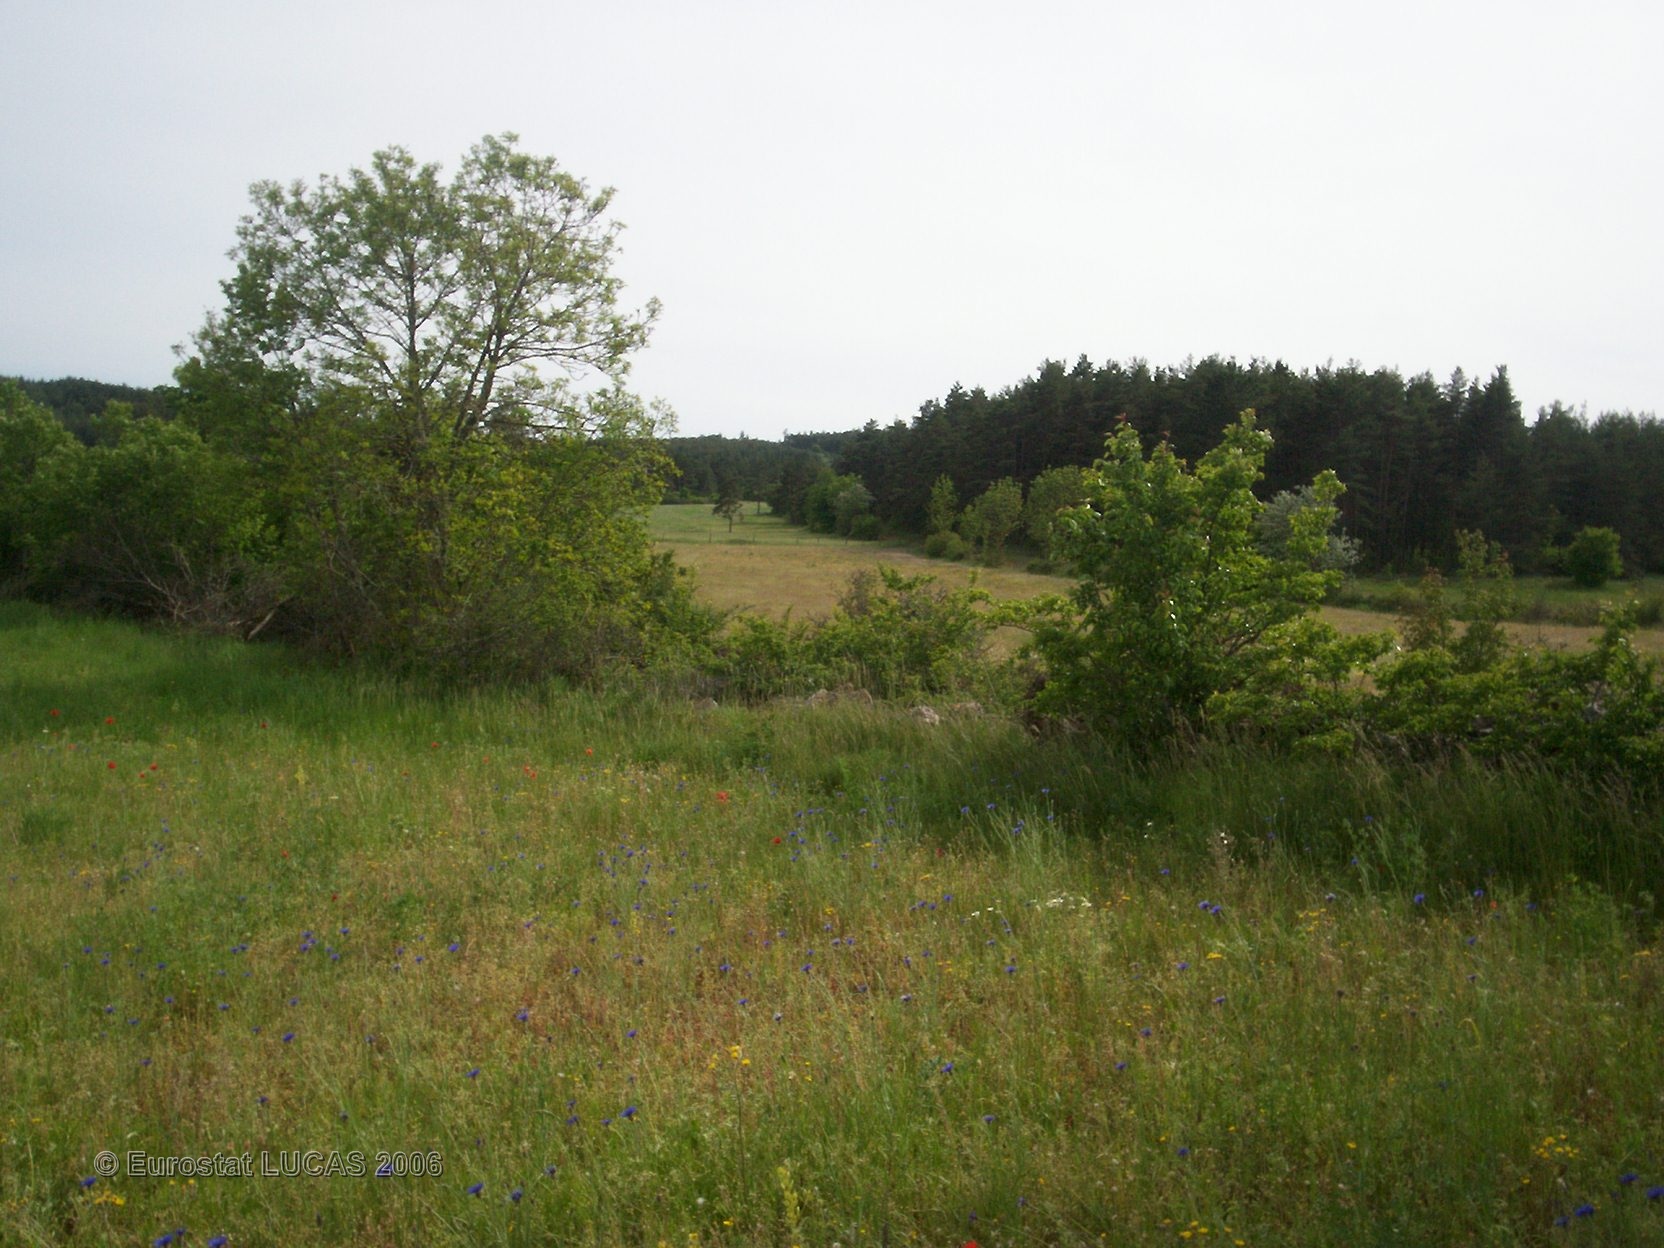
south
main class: Grassland
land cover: Grassland without tree/shrub cover
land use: Agriculture (excluding fallow land and kitchen gardens)
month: June
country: FR
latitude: 44.4680
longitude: 3.4311
